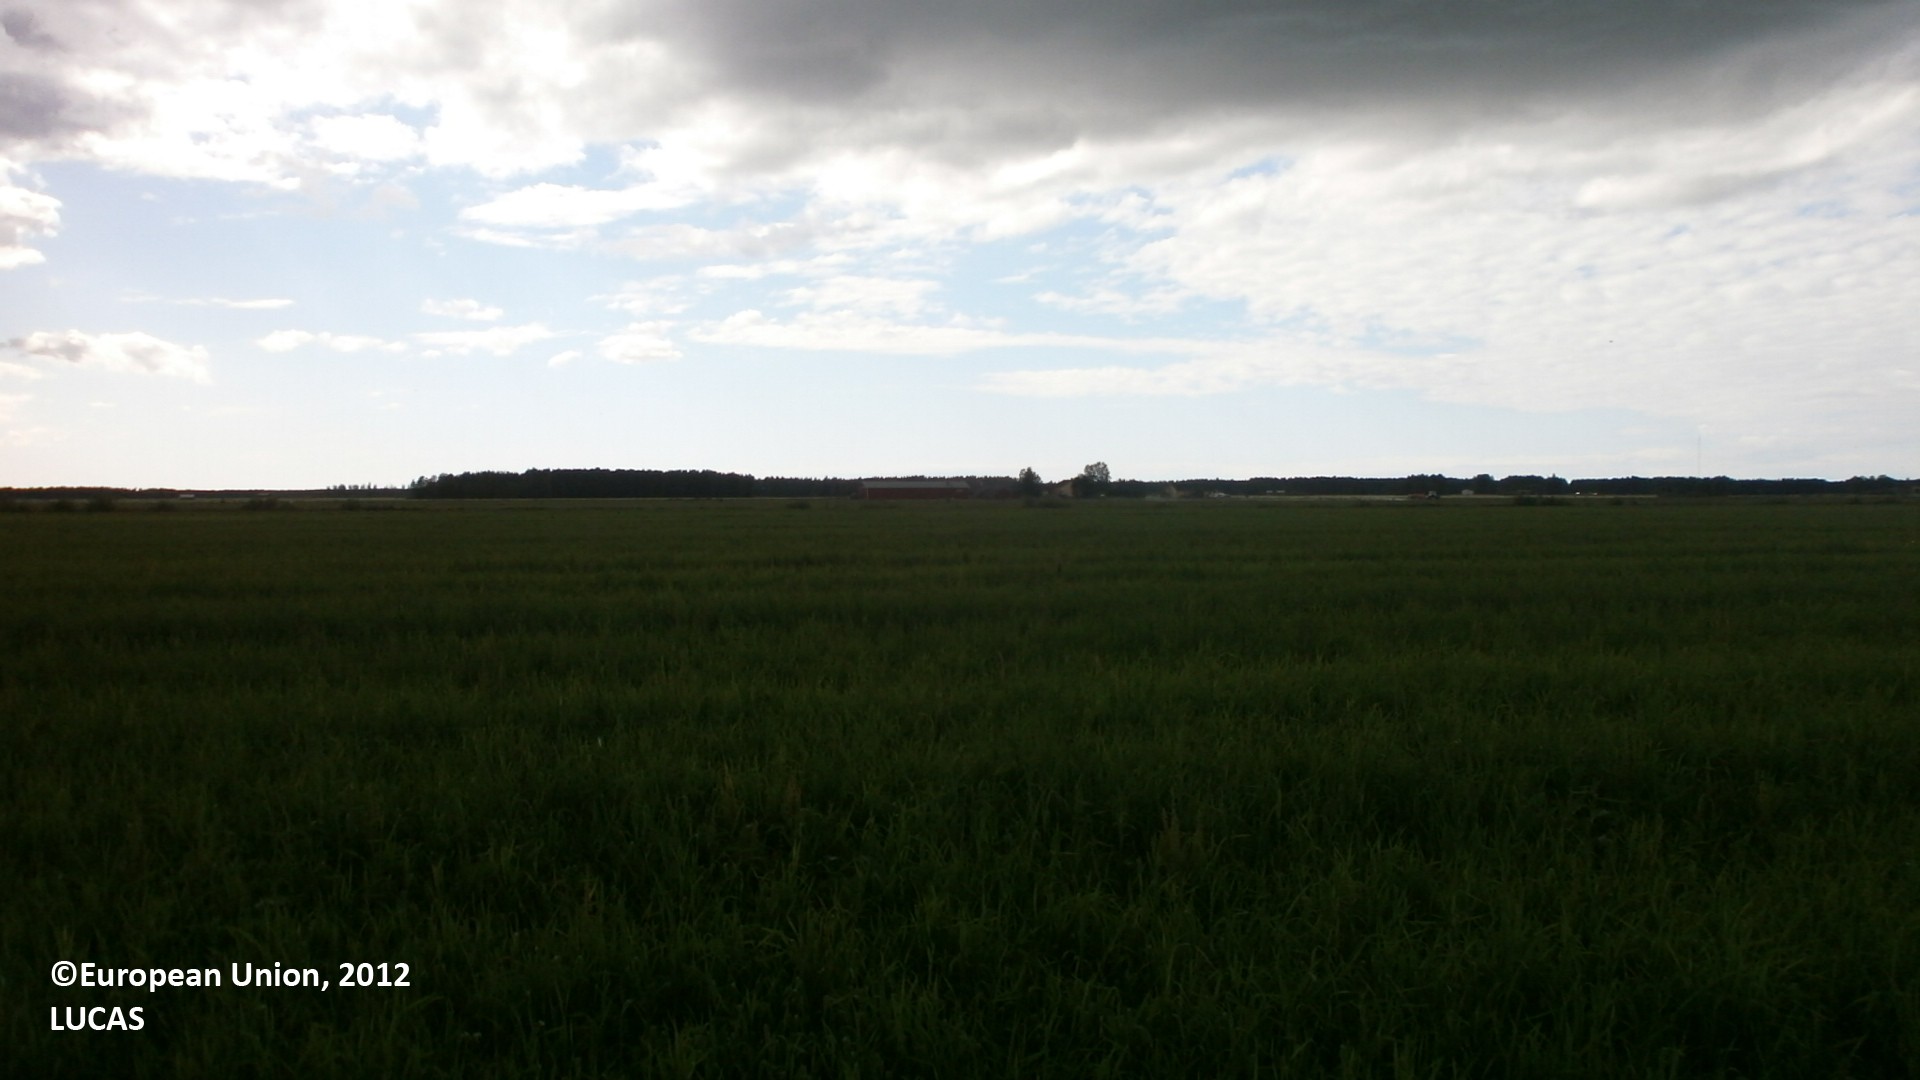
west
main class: Cropland
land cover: Temporary grasslands
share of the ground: > 75 %
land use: Agriculture (excluding fallow land and kitchen gardens)
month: July
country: FI
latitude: 64.1785
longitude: 24.2036
